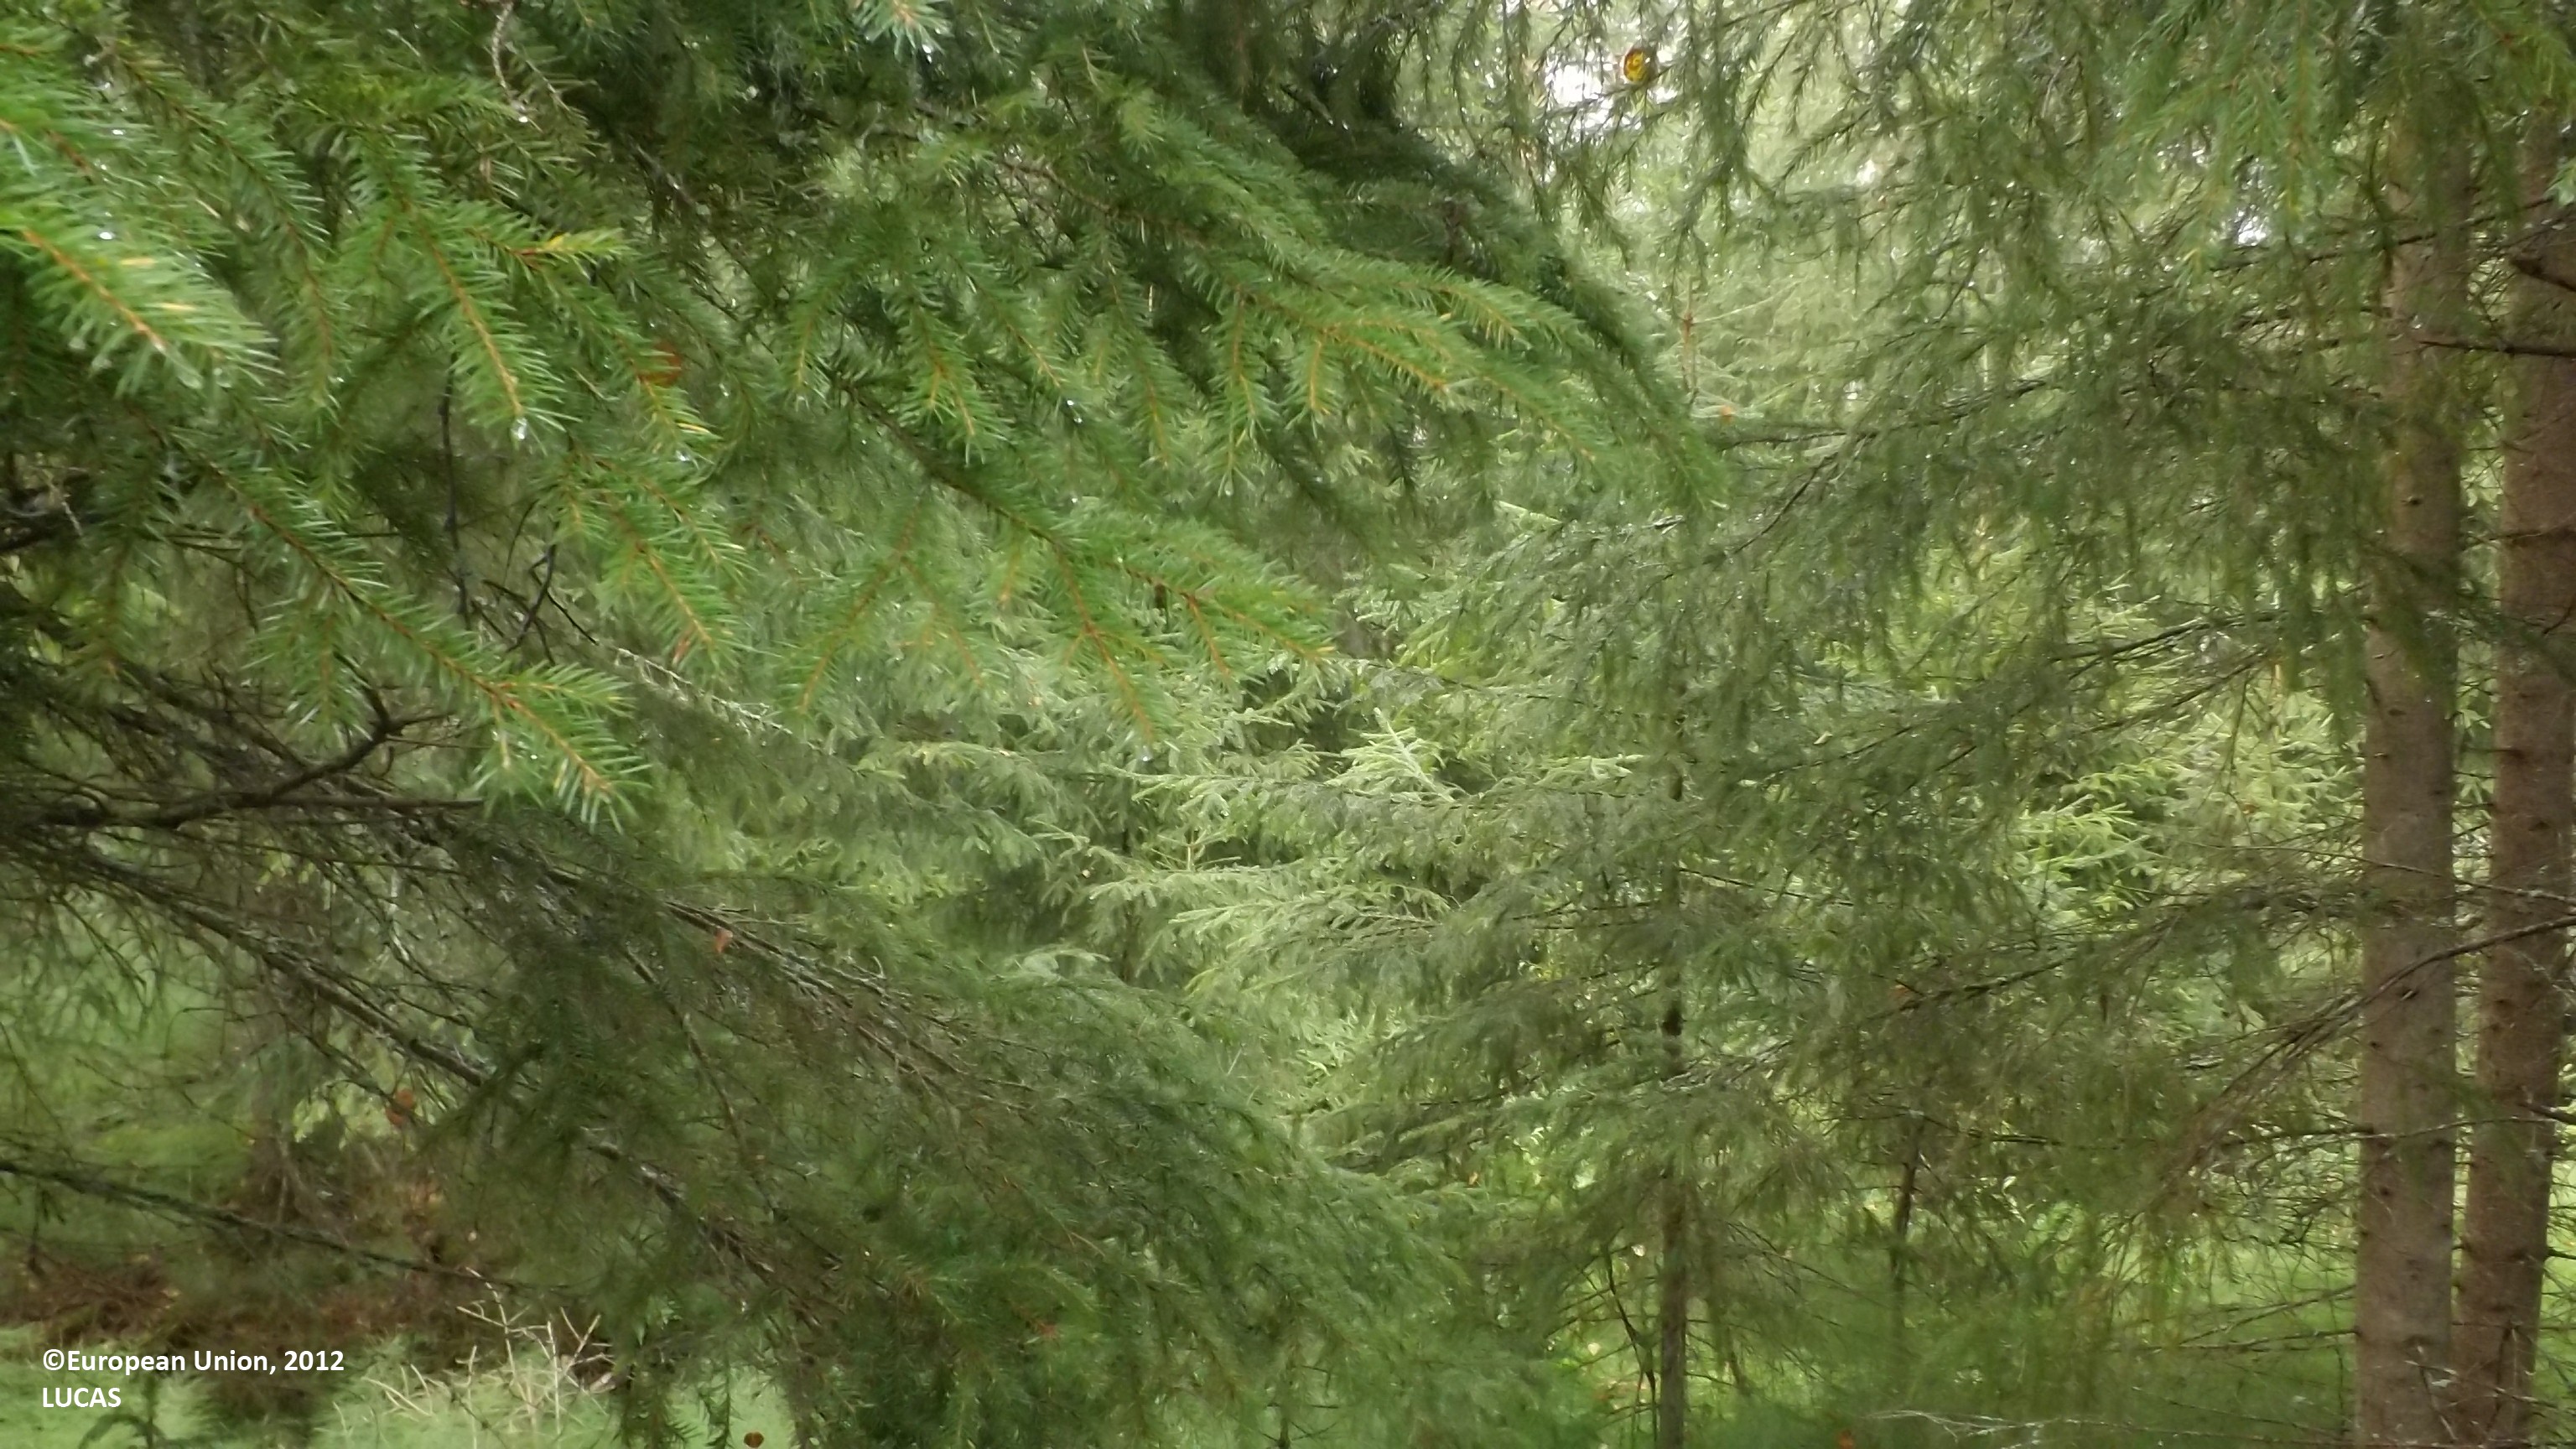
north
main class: Woodland
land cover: Spruce dominated mixed woodland
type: boreal forest
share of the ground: > 75 %
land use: Forestry
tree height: > 5 m
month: August
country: FI
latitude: 63.9710
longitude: 23.8498
